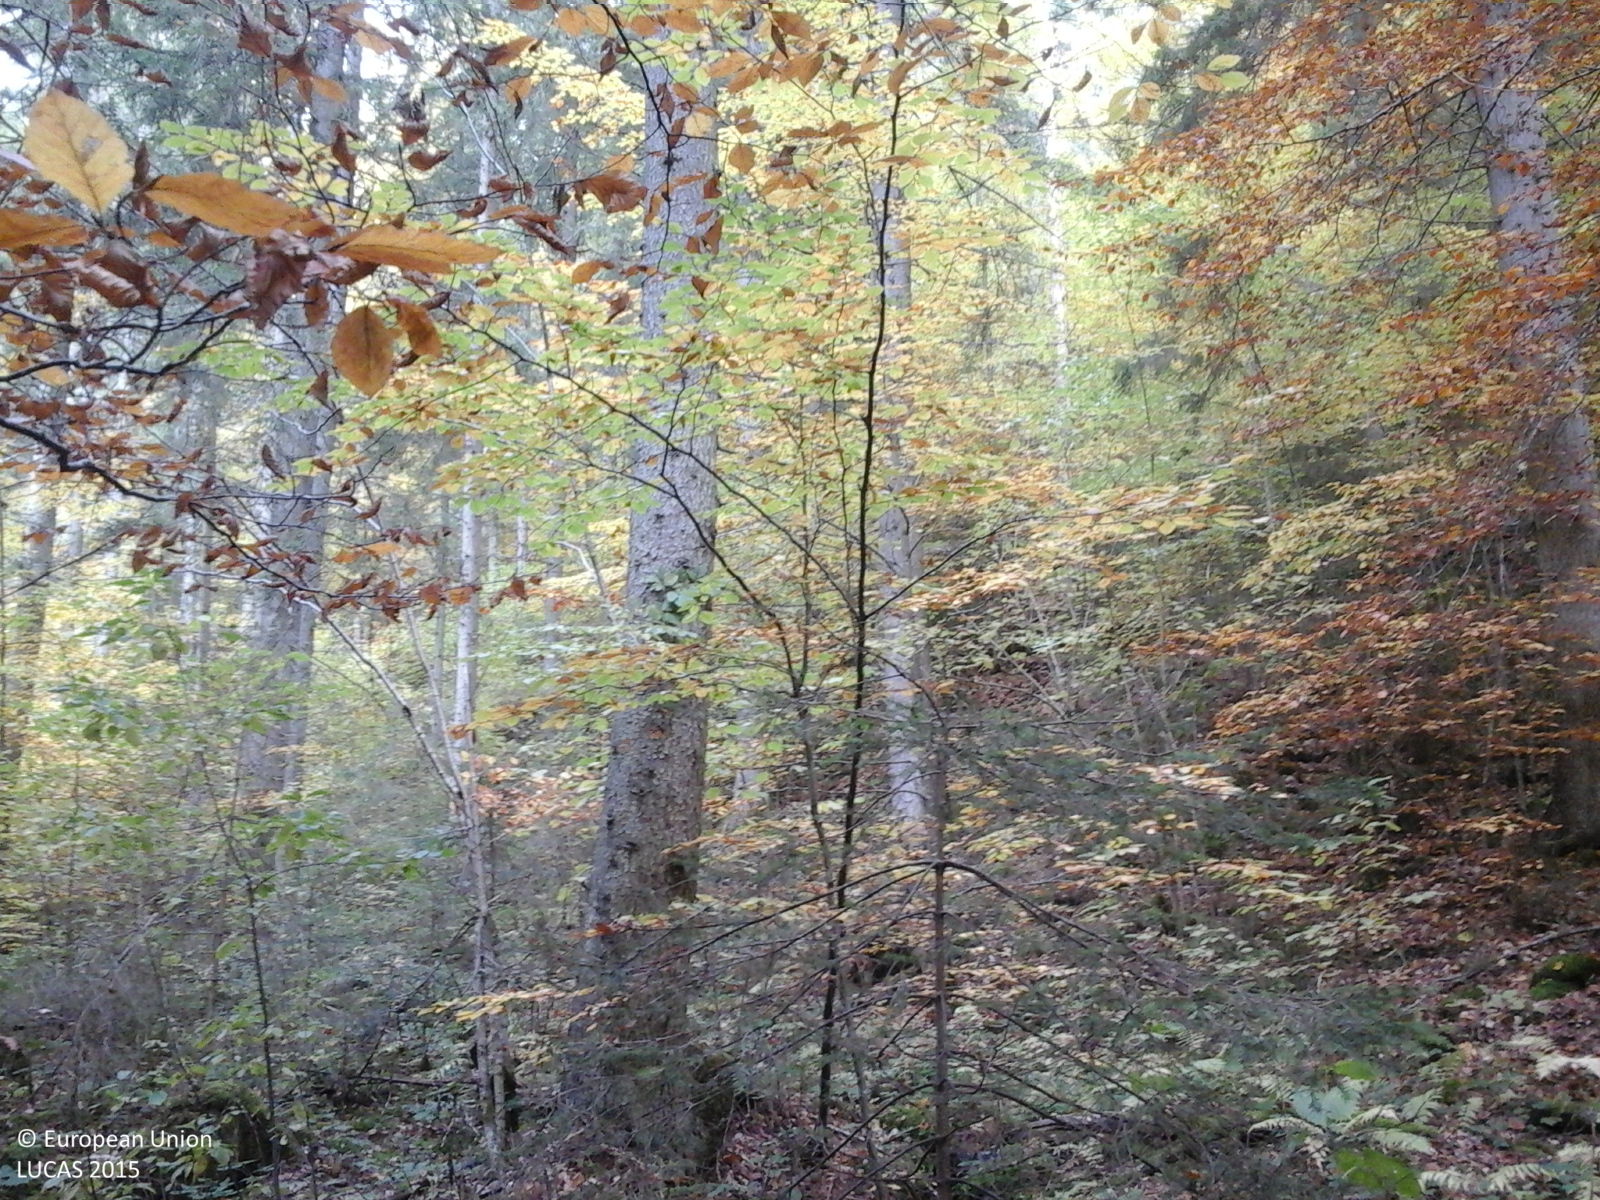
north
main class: Woodland
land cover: Spruce dominated mixed woodland
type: alpine coniferous forest
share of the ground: > 75 %
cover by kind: coniferous forest trees 60 %, broadleaved forest trees 40 %
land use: Forestry
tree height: > 5 m
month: October
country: RO
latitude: 46.5562
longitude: 25.4608
